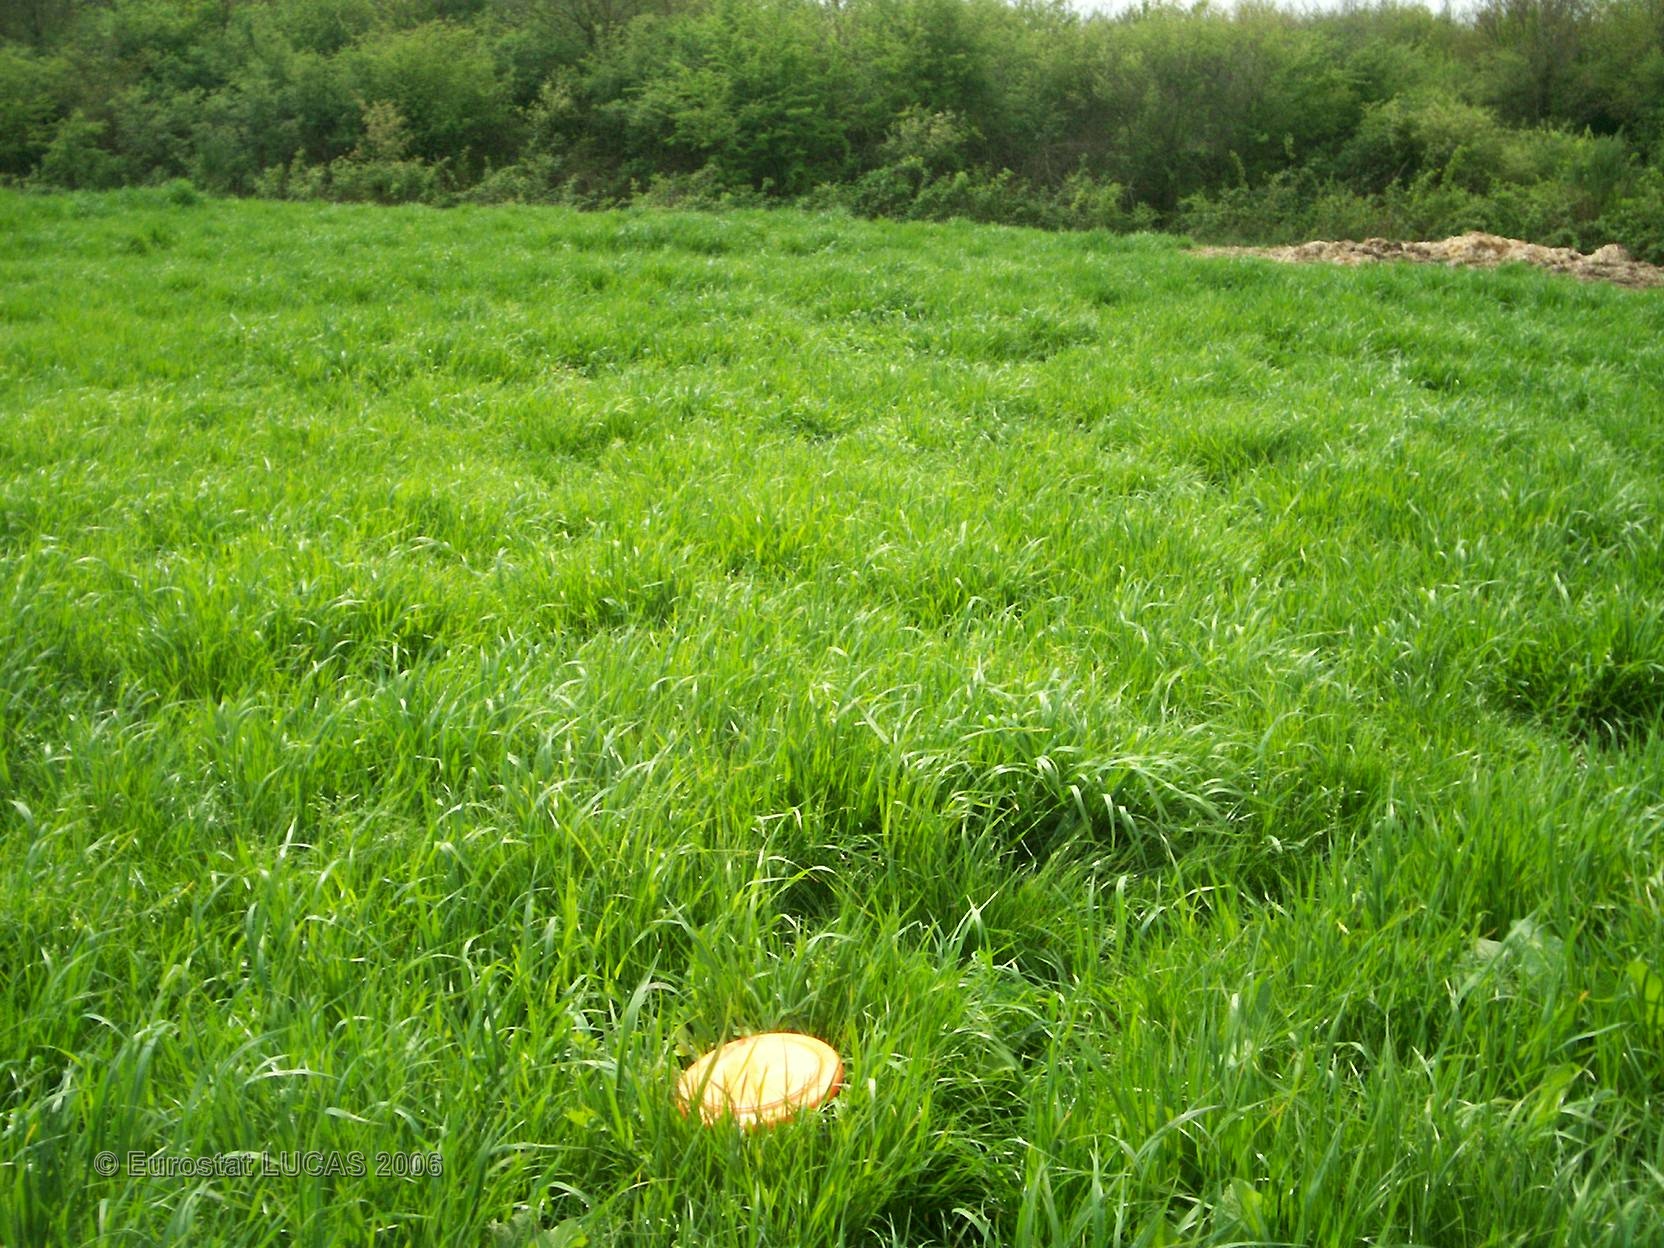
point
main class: Grassland
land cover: Grassland without tree/shrub cover
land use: Agriculture (excluding fallow land and kitchen gardens)
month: April
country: FR
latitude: 46.8286
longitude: -1.2449
